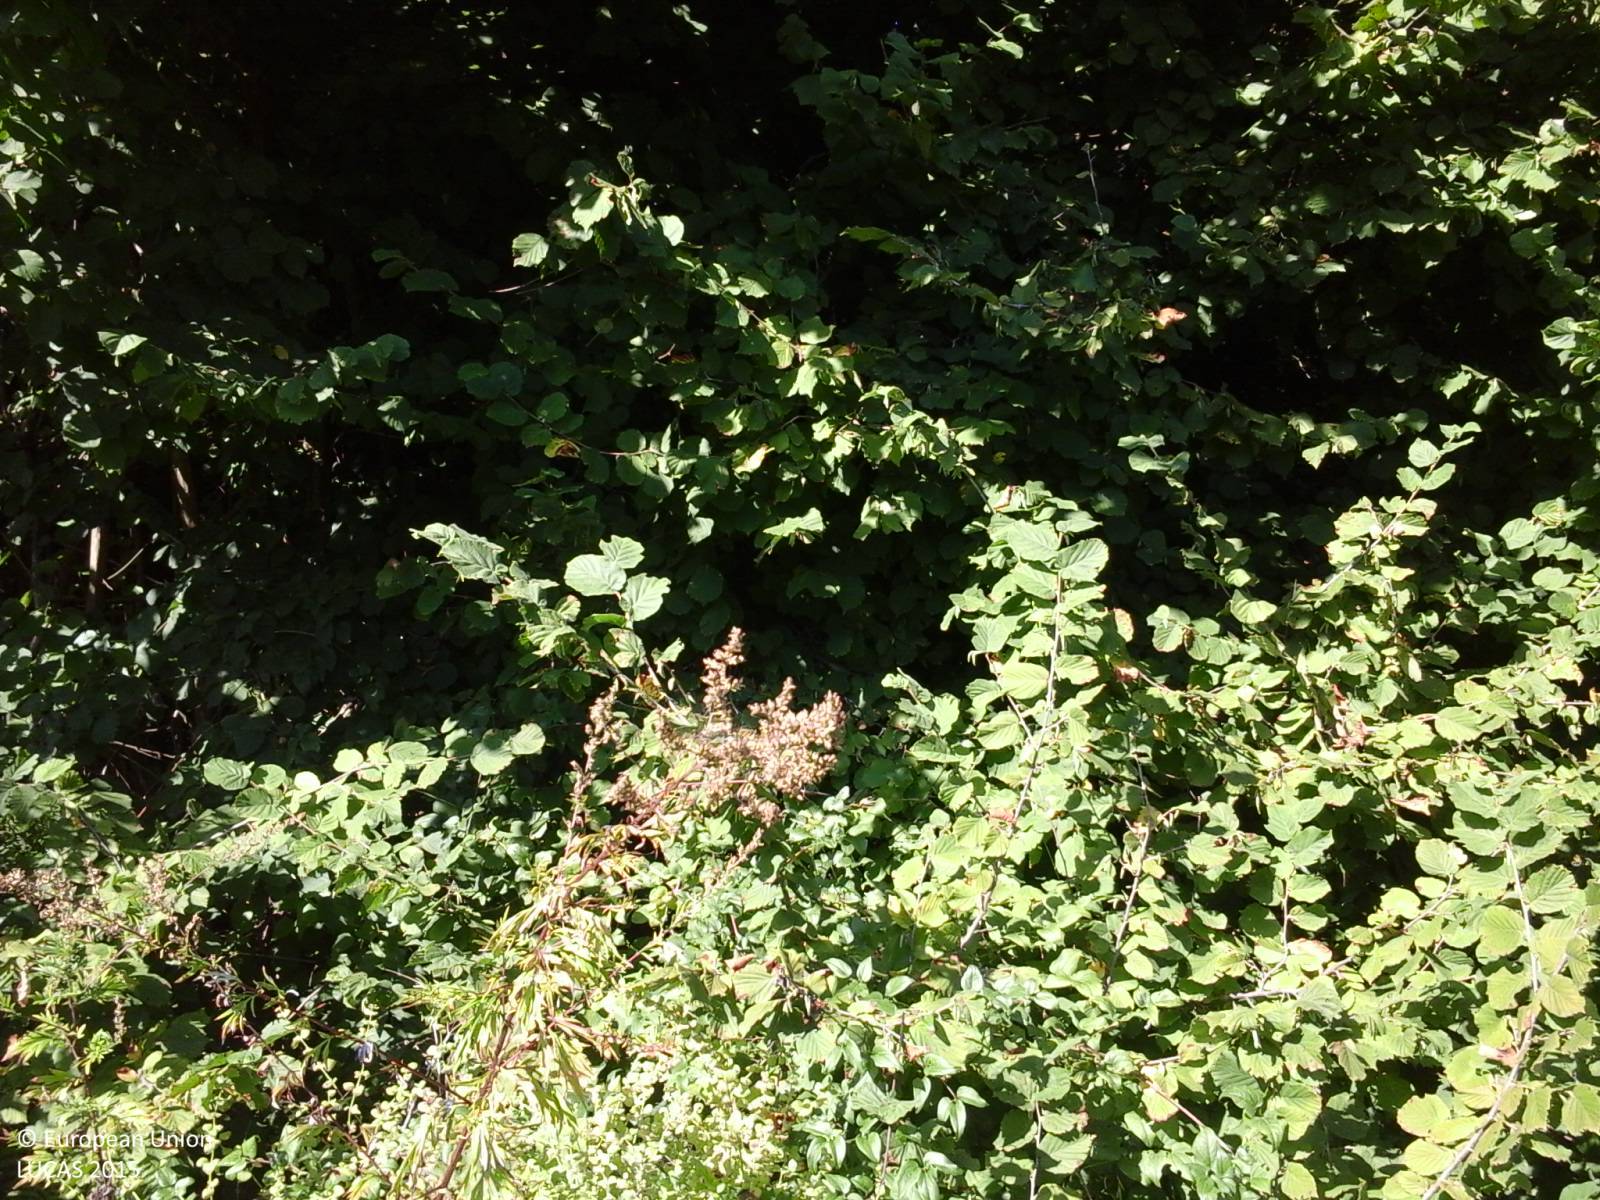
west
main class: Woodland
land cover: Broadleaved woodland
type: thermophilous deciduous forest
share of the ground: > 75 %
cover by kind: broadleaved forest trees 90 %, shrubs 10 %
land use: Forestry
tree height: > 5 m
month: September
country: IT
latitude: 42.7235
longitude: 12.0572
